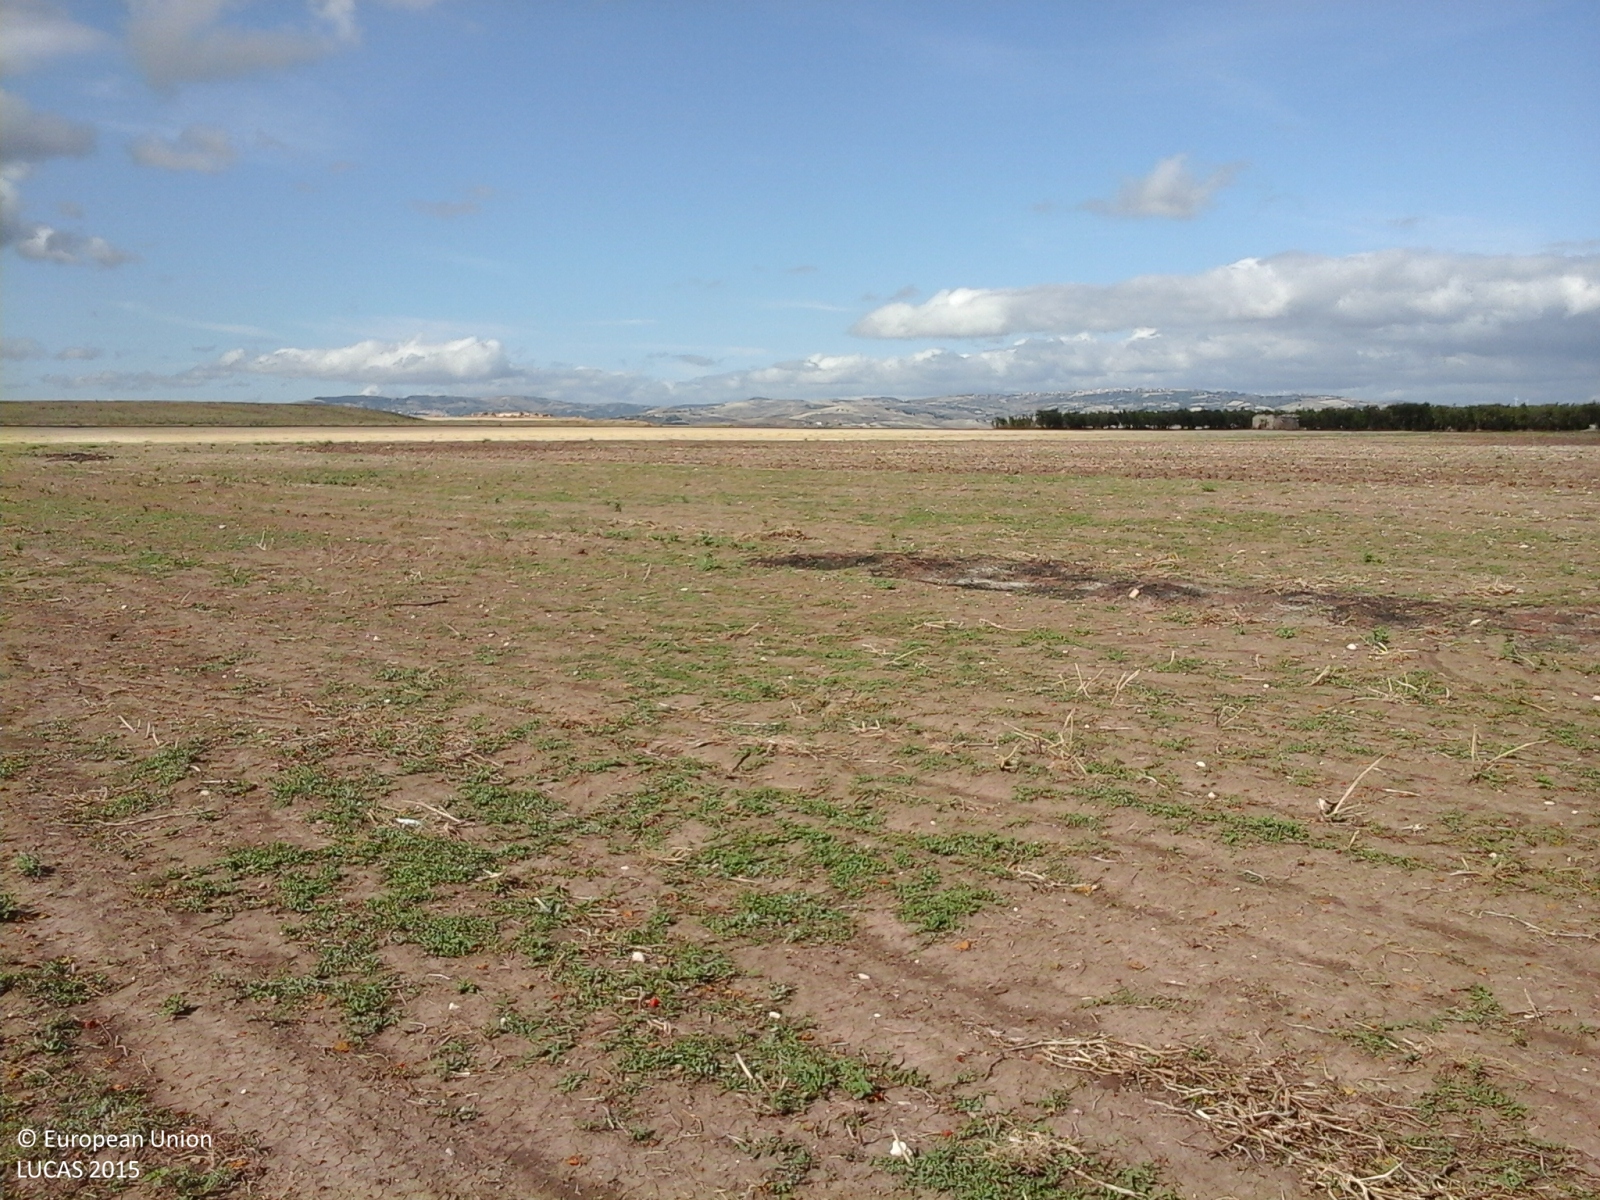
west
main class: Cropland
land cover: Tomatoes
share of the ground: < 10 %
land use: Agriculture (excluding fallow land and kitchen gardens)
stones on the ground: < 10 %
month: September
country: IT
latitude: 41.6730
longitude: 15.1363
